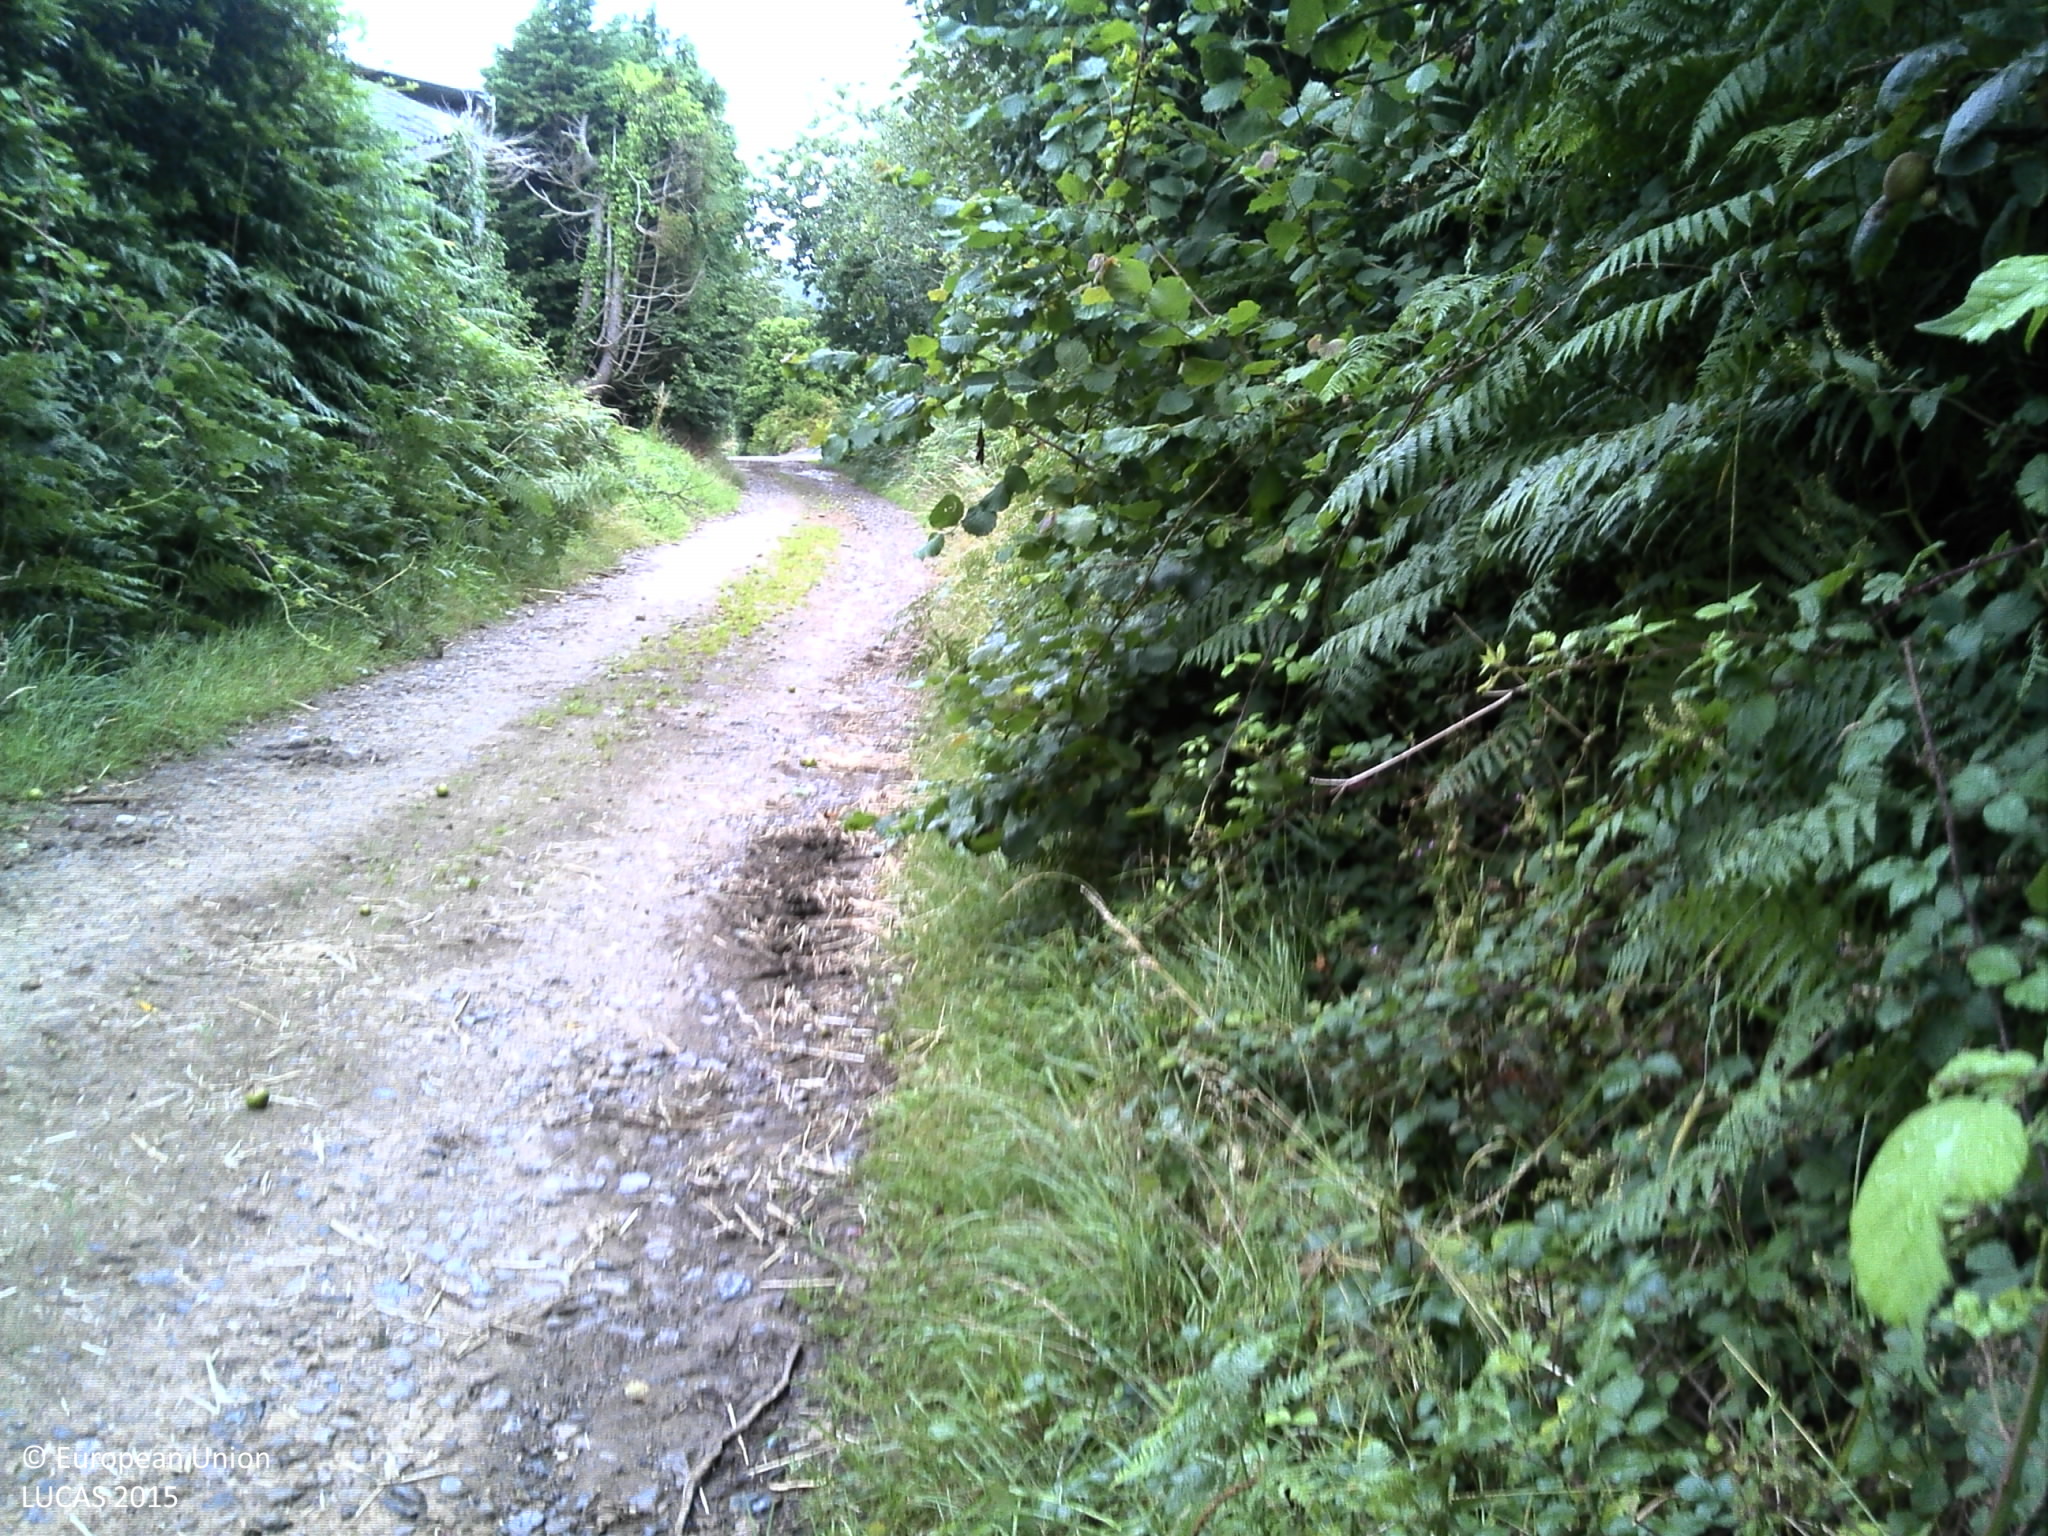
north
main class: Woodland
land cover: Broadleaved woodland
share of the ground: > 75 %
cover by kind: broadleaved forest trees 100 %
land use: Semi-natural and natural areas not in use
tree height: > 5 m
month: July
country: FR
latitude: 48.3903
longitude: -4.2322
